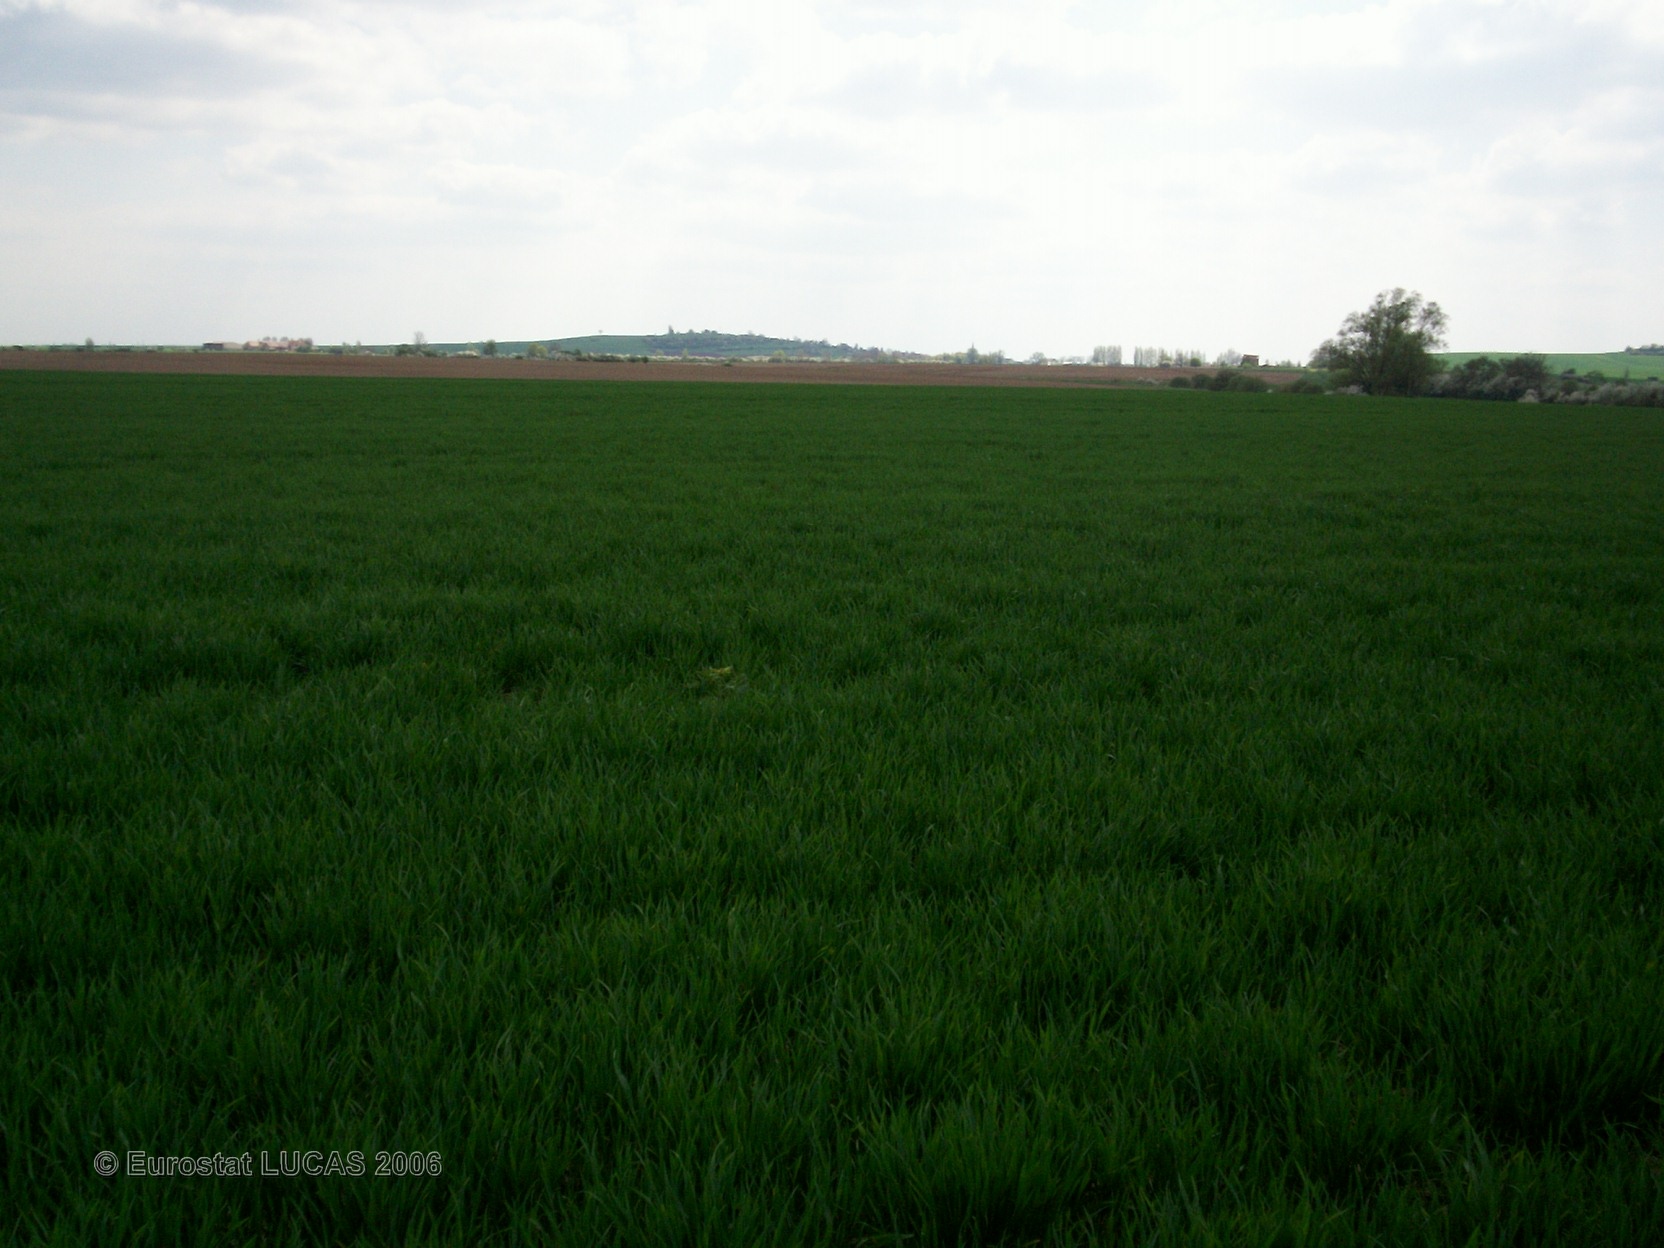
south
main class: Cropland
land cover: Common wheat
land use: Agriculture (excluding fallow land and kitchen gardens)
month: April
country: FR
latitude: 49.0035
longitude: 6.7332
